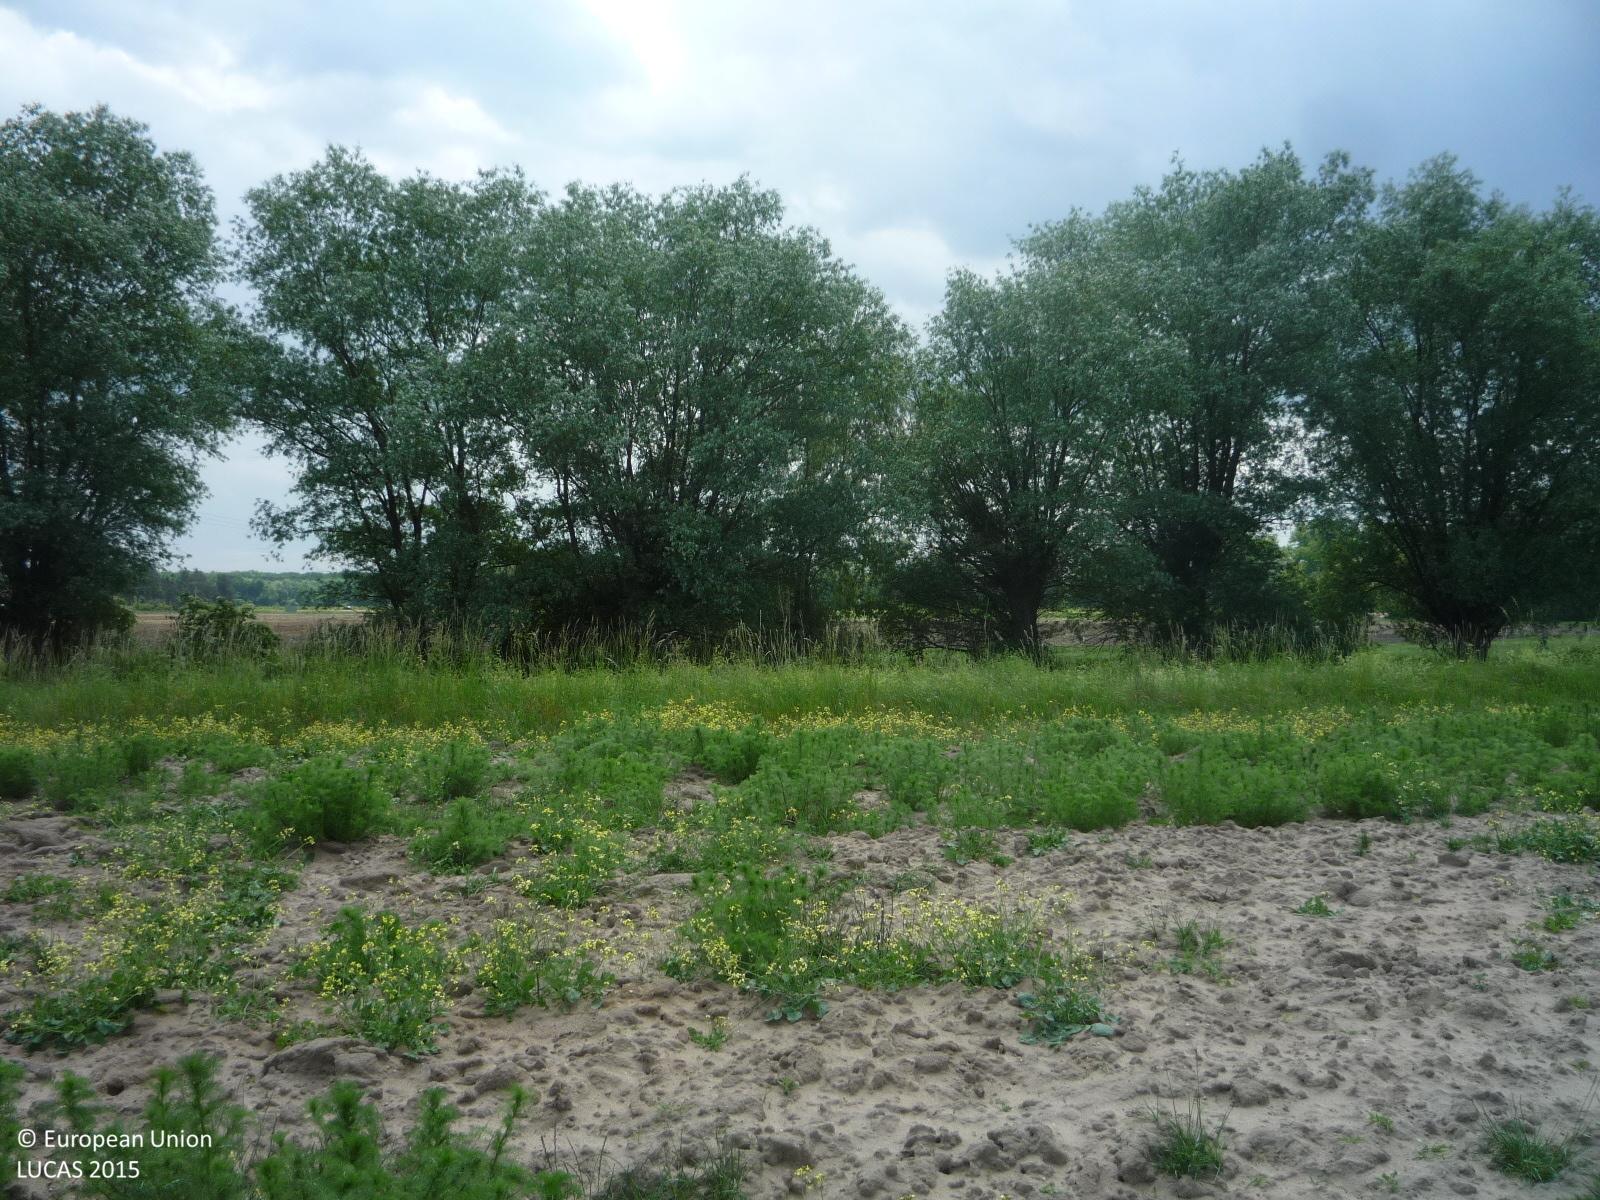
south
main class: Grassland
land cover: Spontaneously vegetated surfaces
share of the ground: 25 - 50 %
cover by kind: unconsolidated bare surface 55 %, herbaceous plants 45 %
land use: Fallow land
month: May
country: CZ
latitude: 50.1863
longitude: 14.9185
